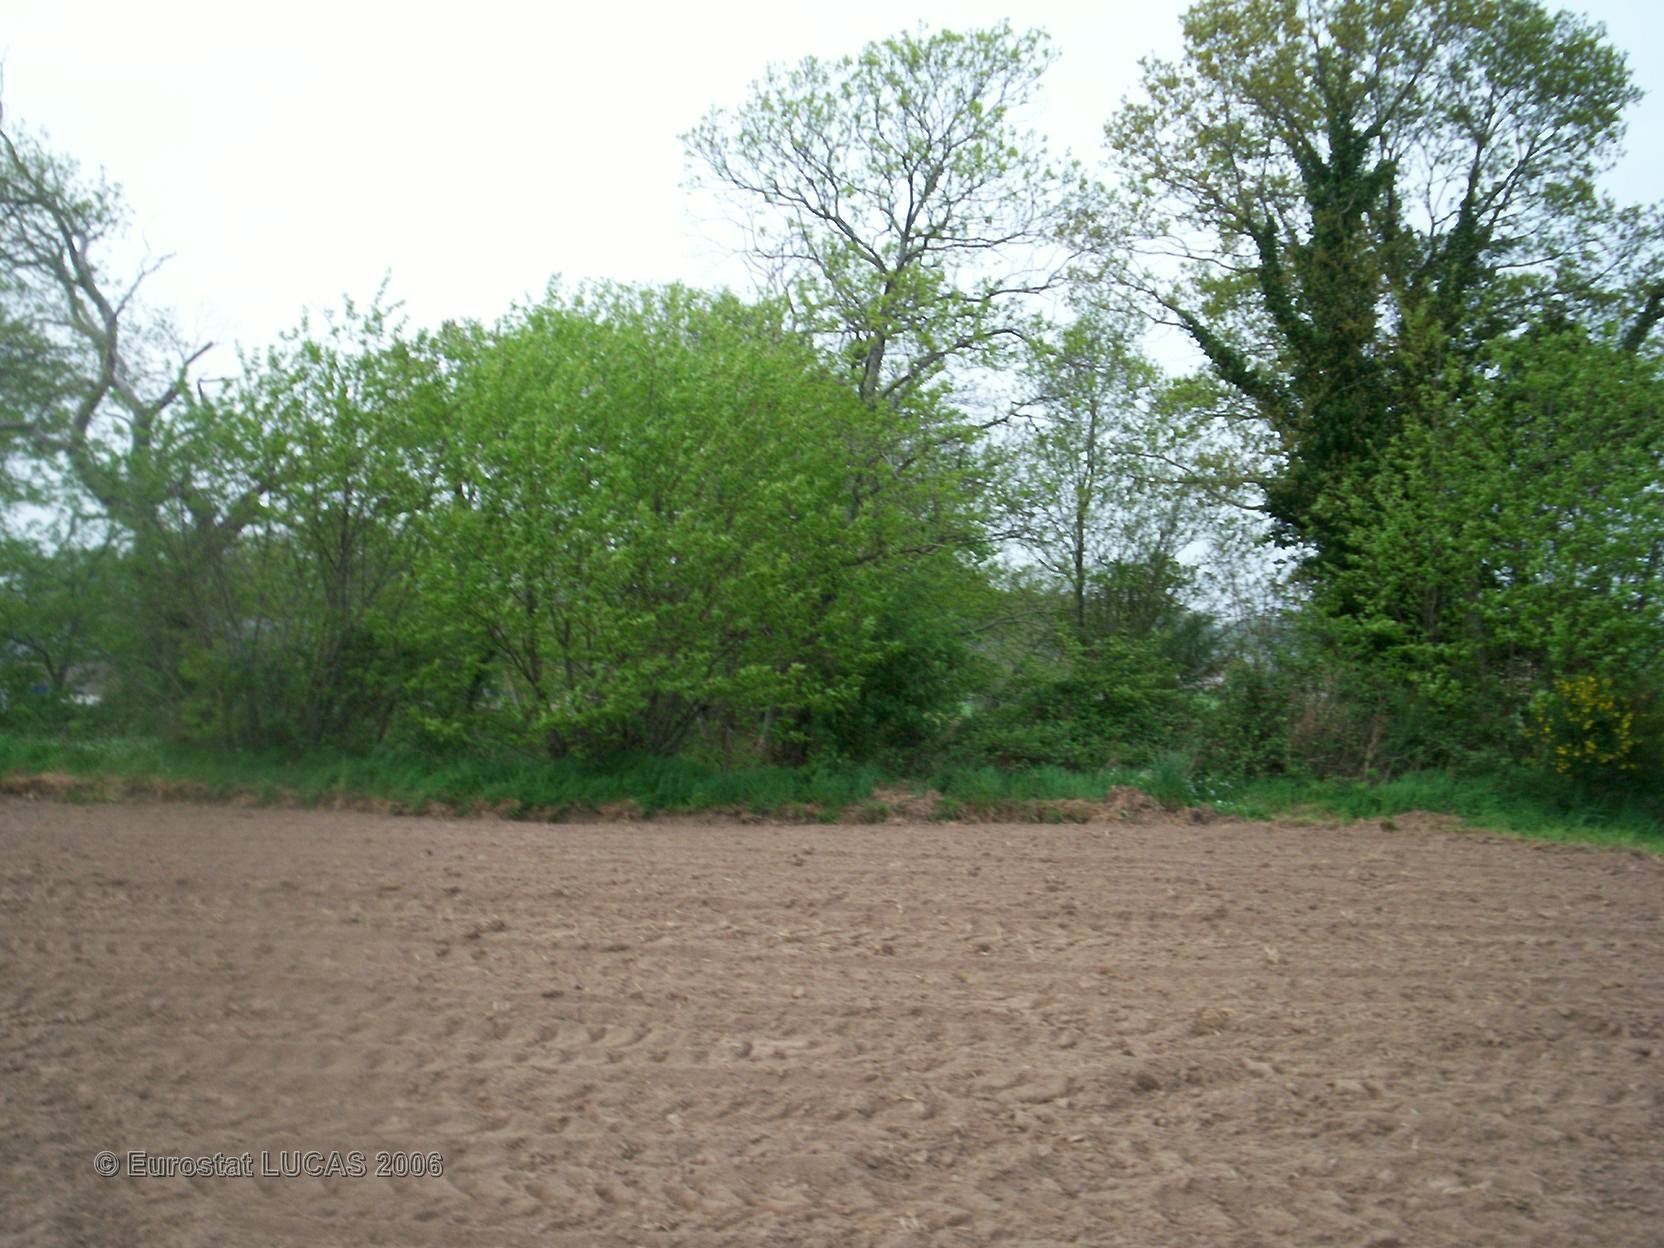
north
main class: Cropland
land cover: Maize
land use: Agriculture (excluding fallow land and kitchen gardens)
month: May
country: FR
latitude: 47.6512
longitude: -2.2085
